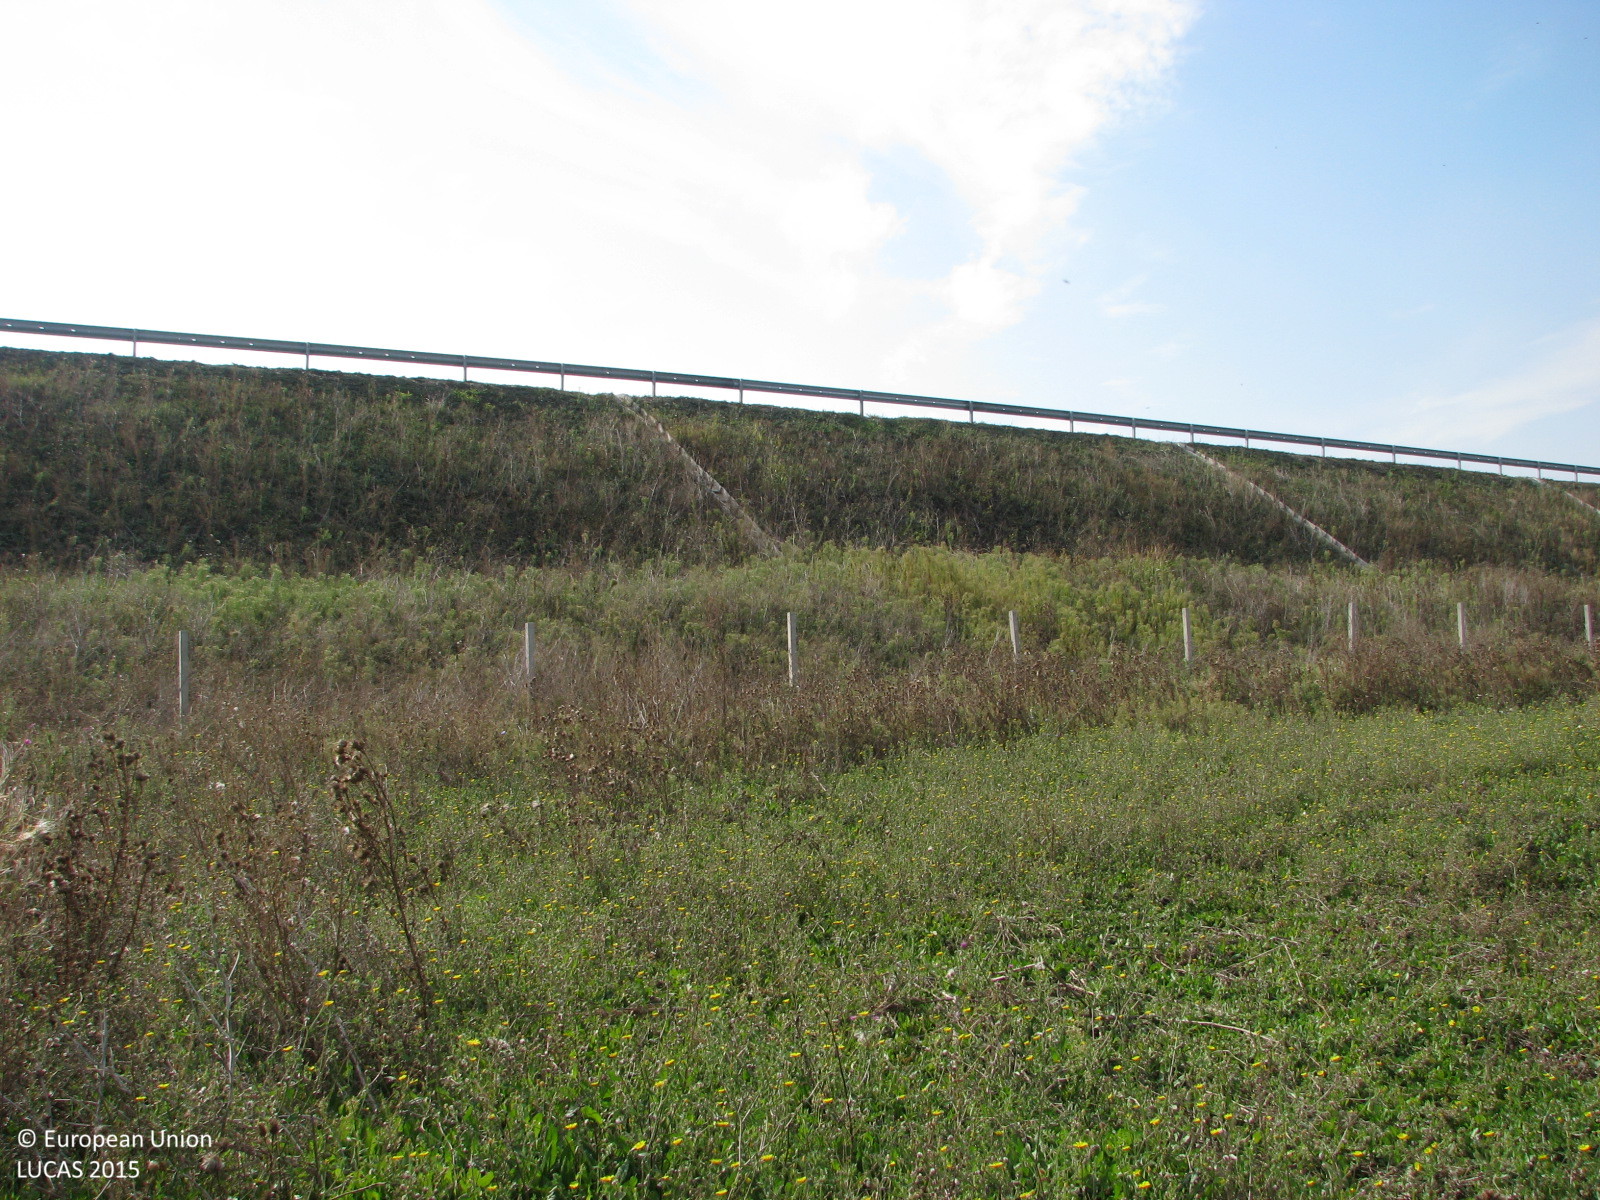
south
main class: Grassland
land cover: Grassland without tree/shrub cover
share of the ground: > 75 %
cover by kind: herbaceous plants 100 %
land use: Semi-natural and natural areas not in use
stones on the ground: < 10 %
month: October
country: BG
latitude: 42.4392
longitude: 25.9931
